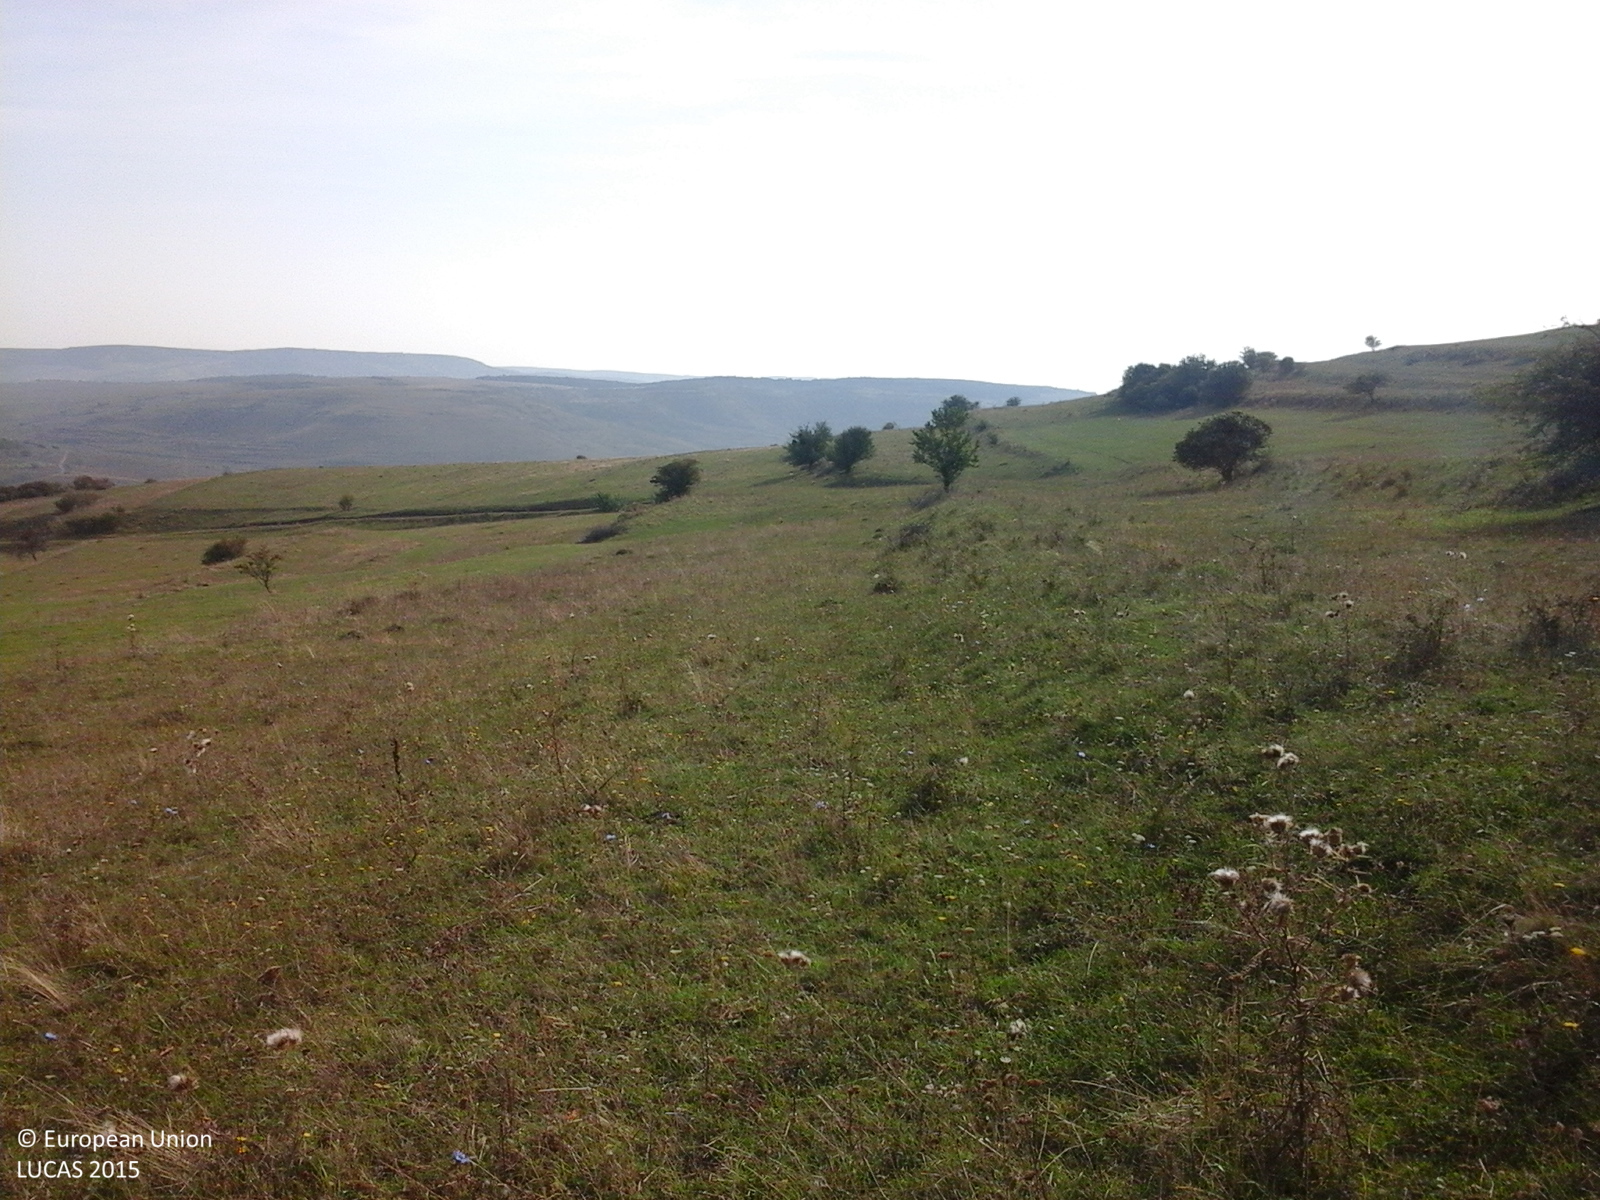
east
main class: Grassland
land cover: Grassland without tree/shrub cover
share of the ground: > 75 %
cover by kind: herbaceous plants 100 %
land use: Agriculture (excluding fallow land and kitchen gardens)
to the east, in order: Grassland without tree/shrub cover; Single bushes/trees; Grassland without tree/shrub cover; Single bushes/trees; Grassland without tree/shrub cover; Tracks; Grassland without tree/shrub cover
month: September
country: RO
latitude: 46.8240
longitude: 23.3457
